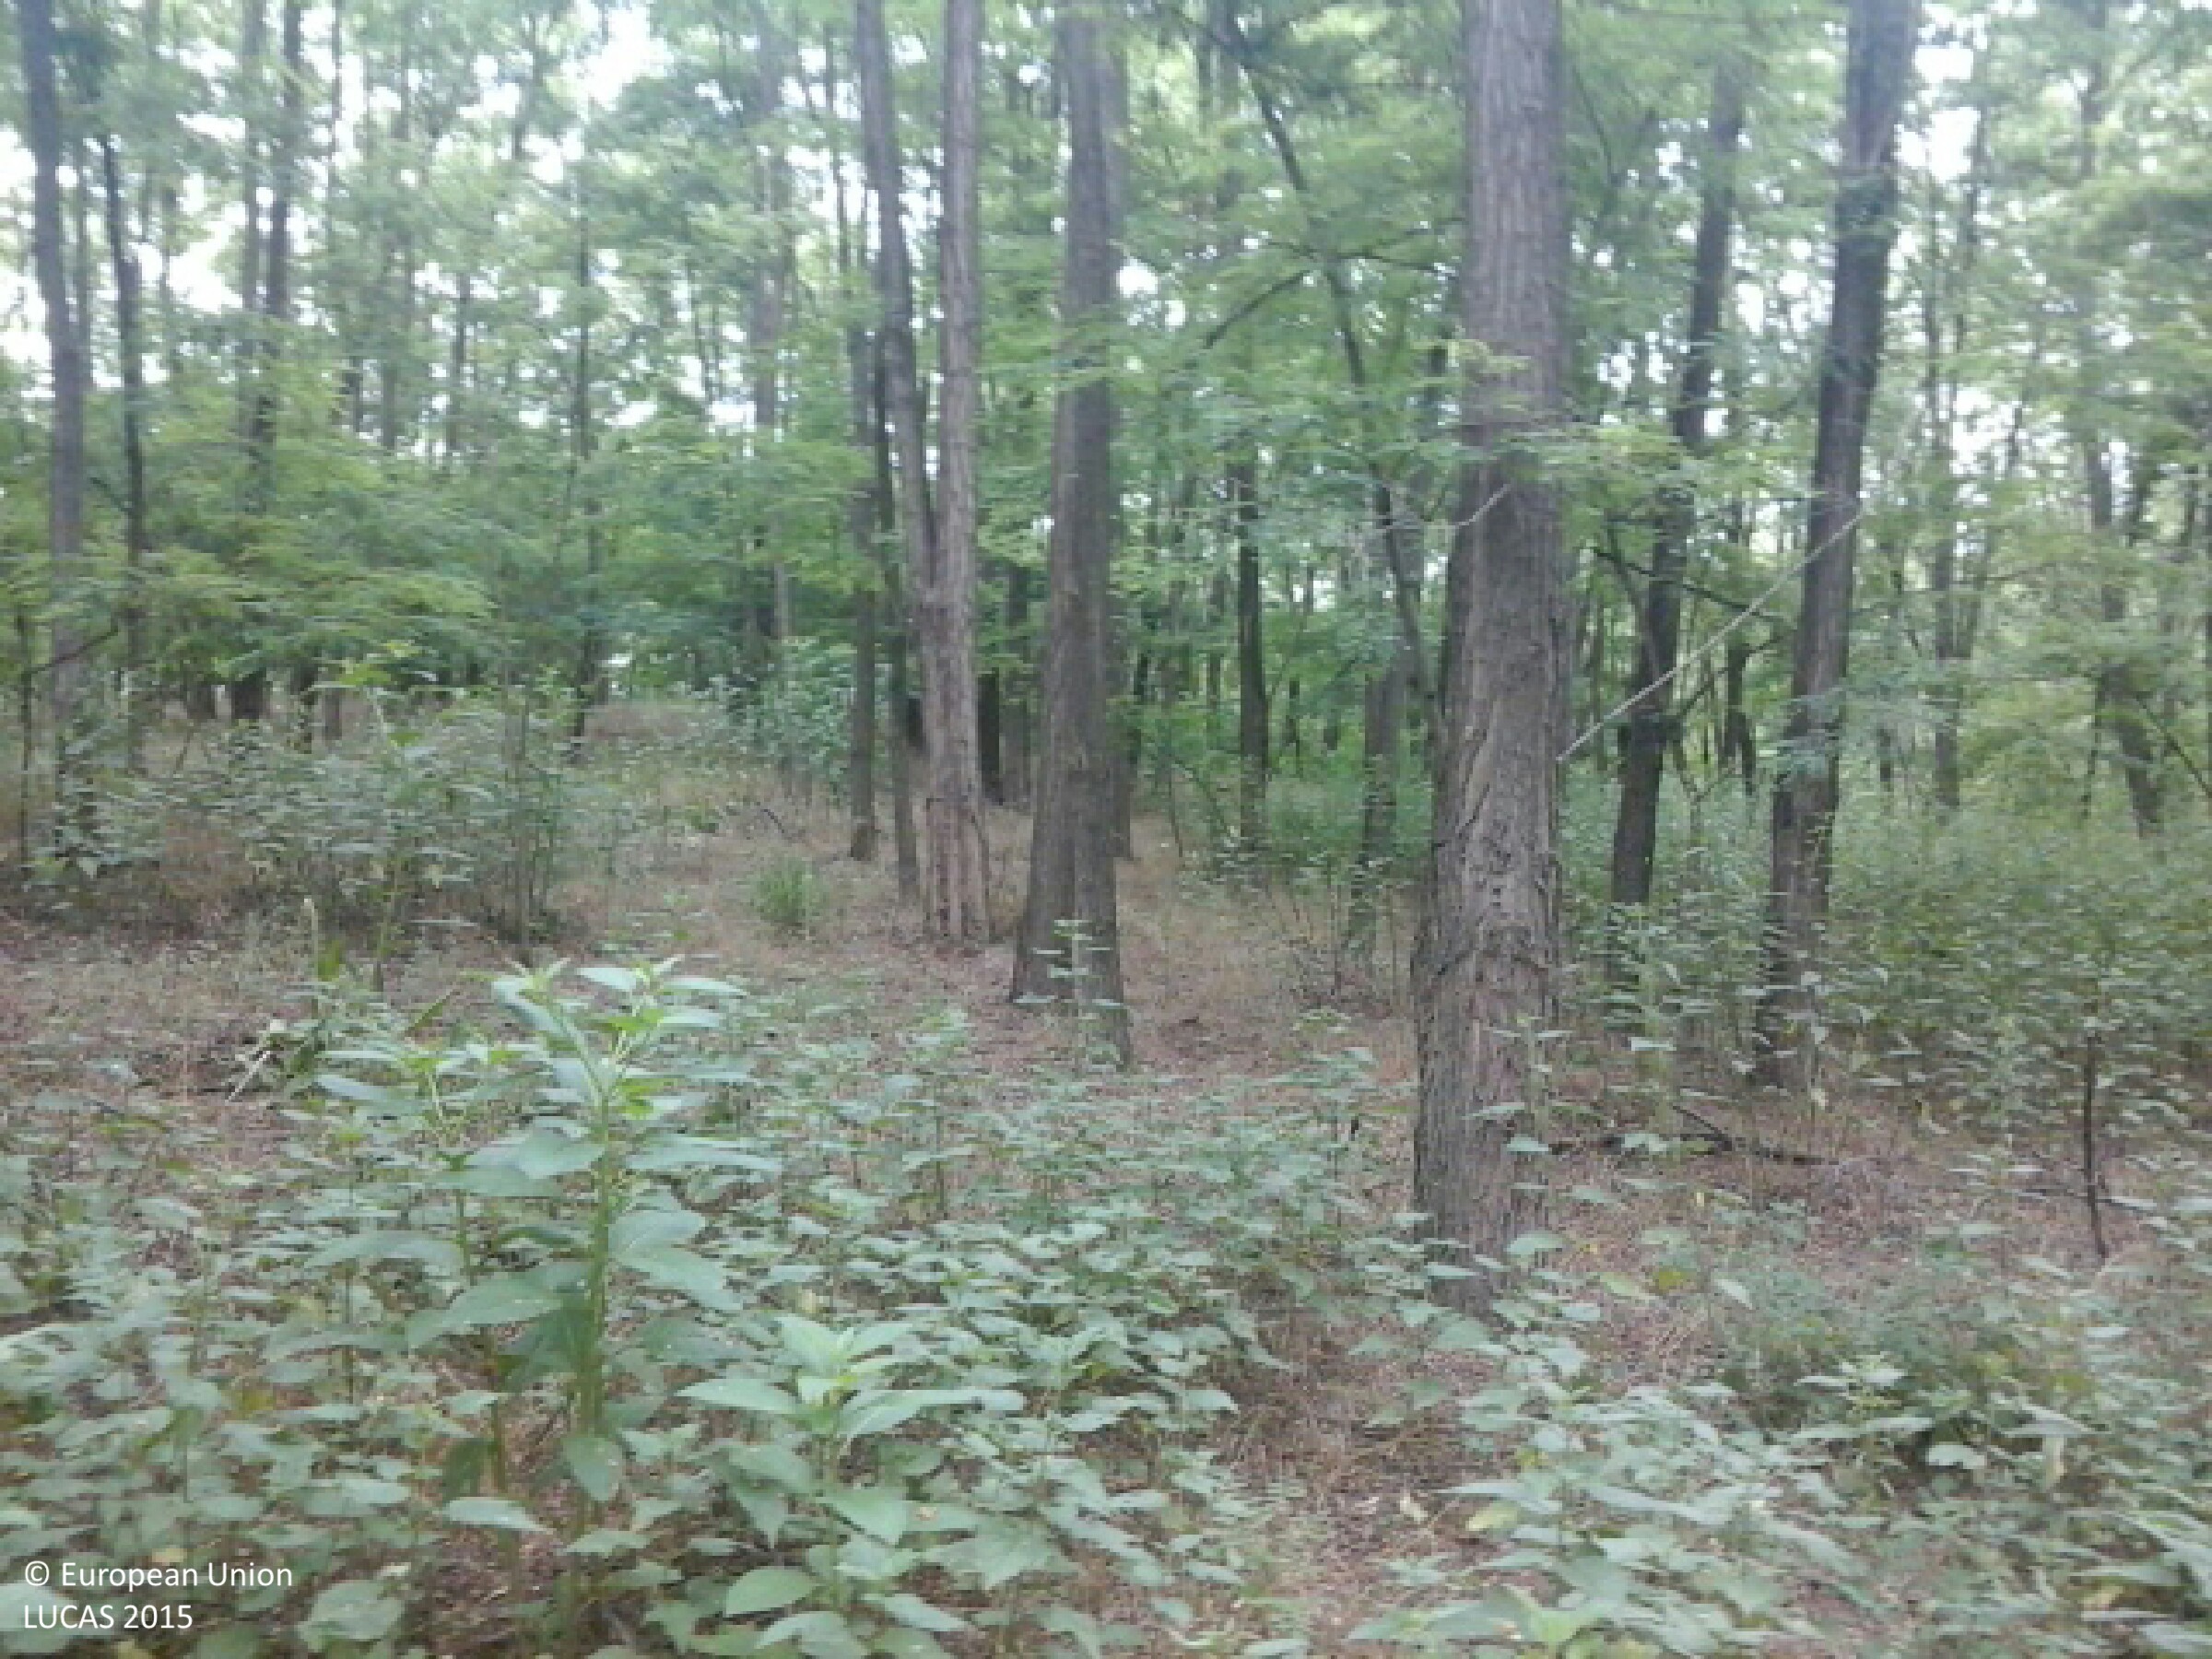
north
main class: Woodland
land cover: Broadleaved woodland
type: mesophytic deciduous forest
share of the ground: > 75 %
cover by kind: broadleaved forest trees 95 %, herbaceous plants 5 %
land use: Forestry
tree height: > 5 m
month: June
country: HU
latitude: 47.9731
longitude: 22.0960
